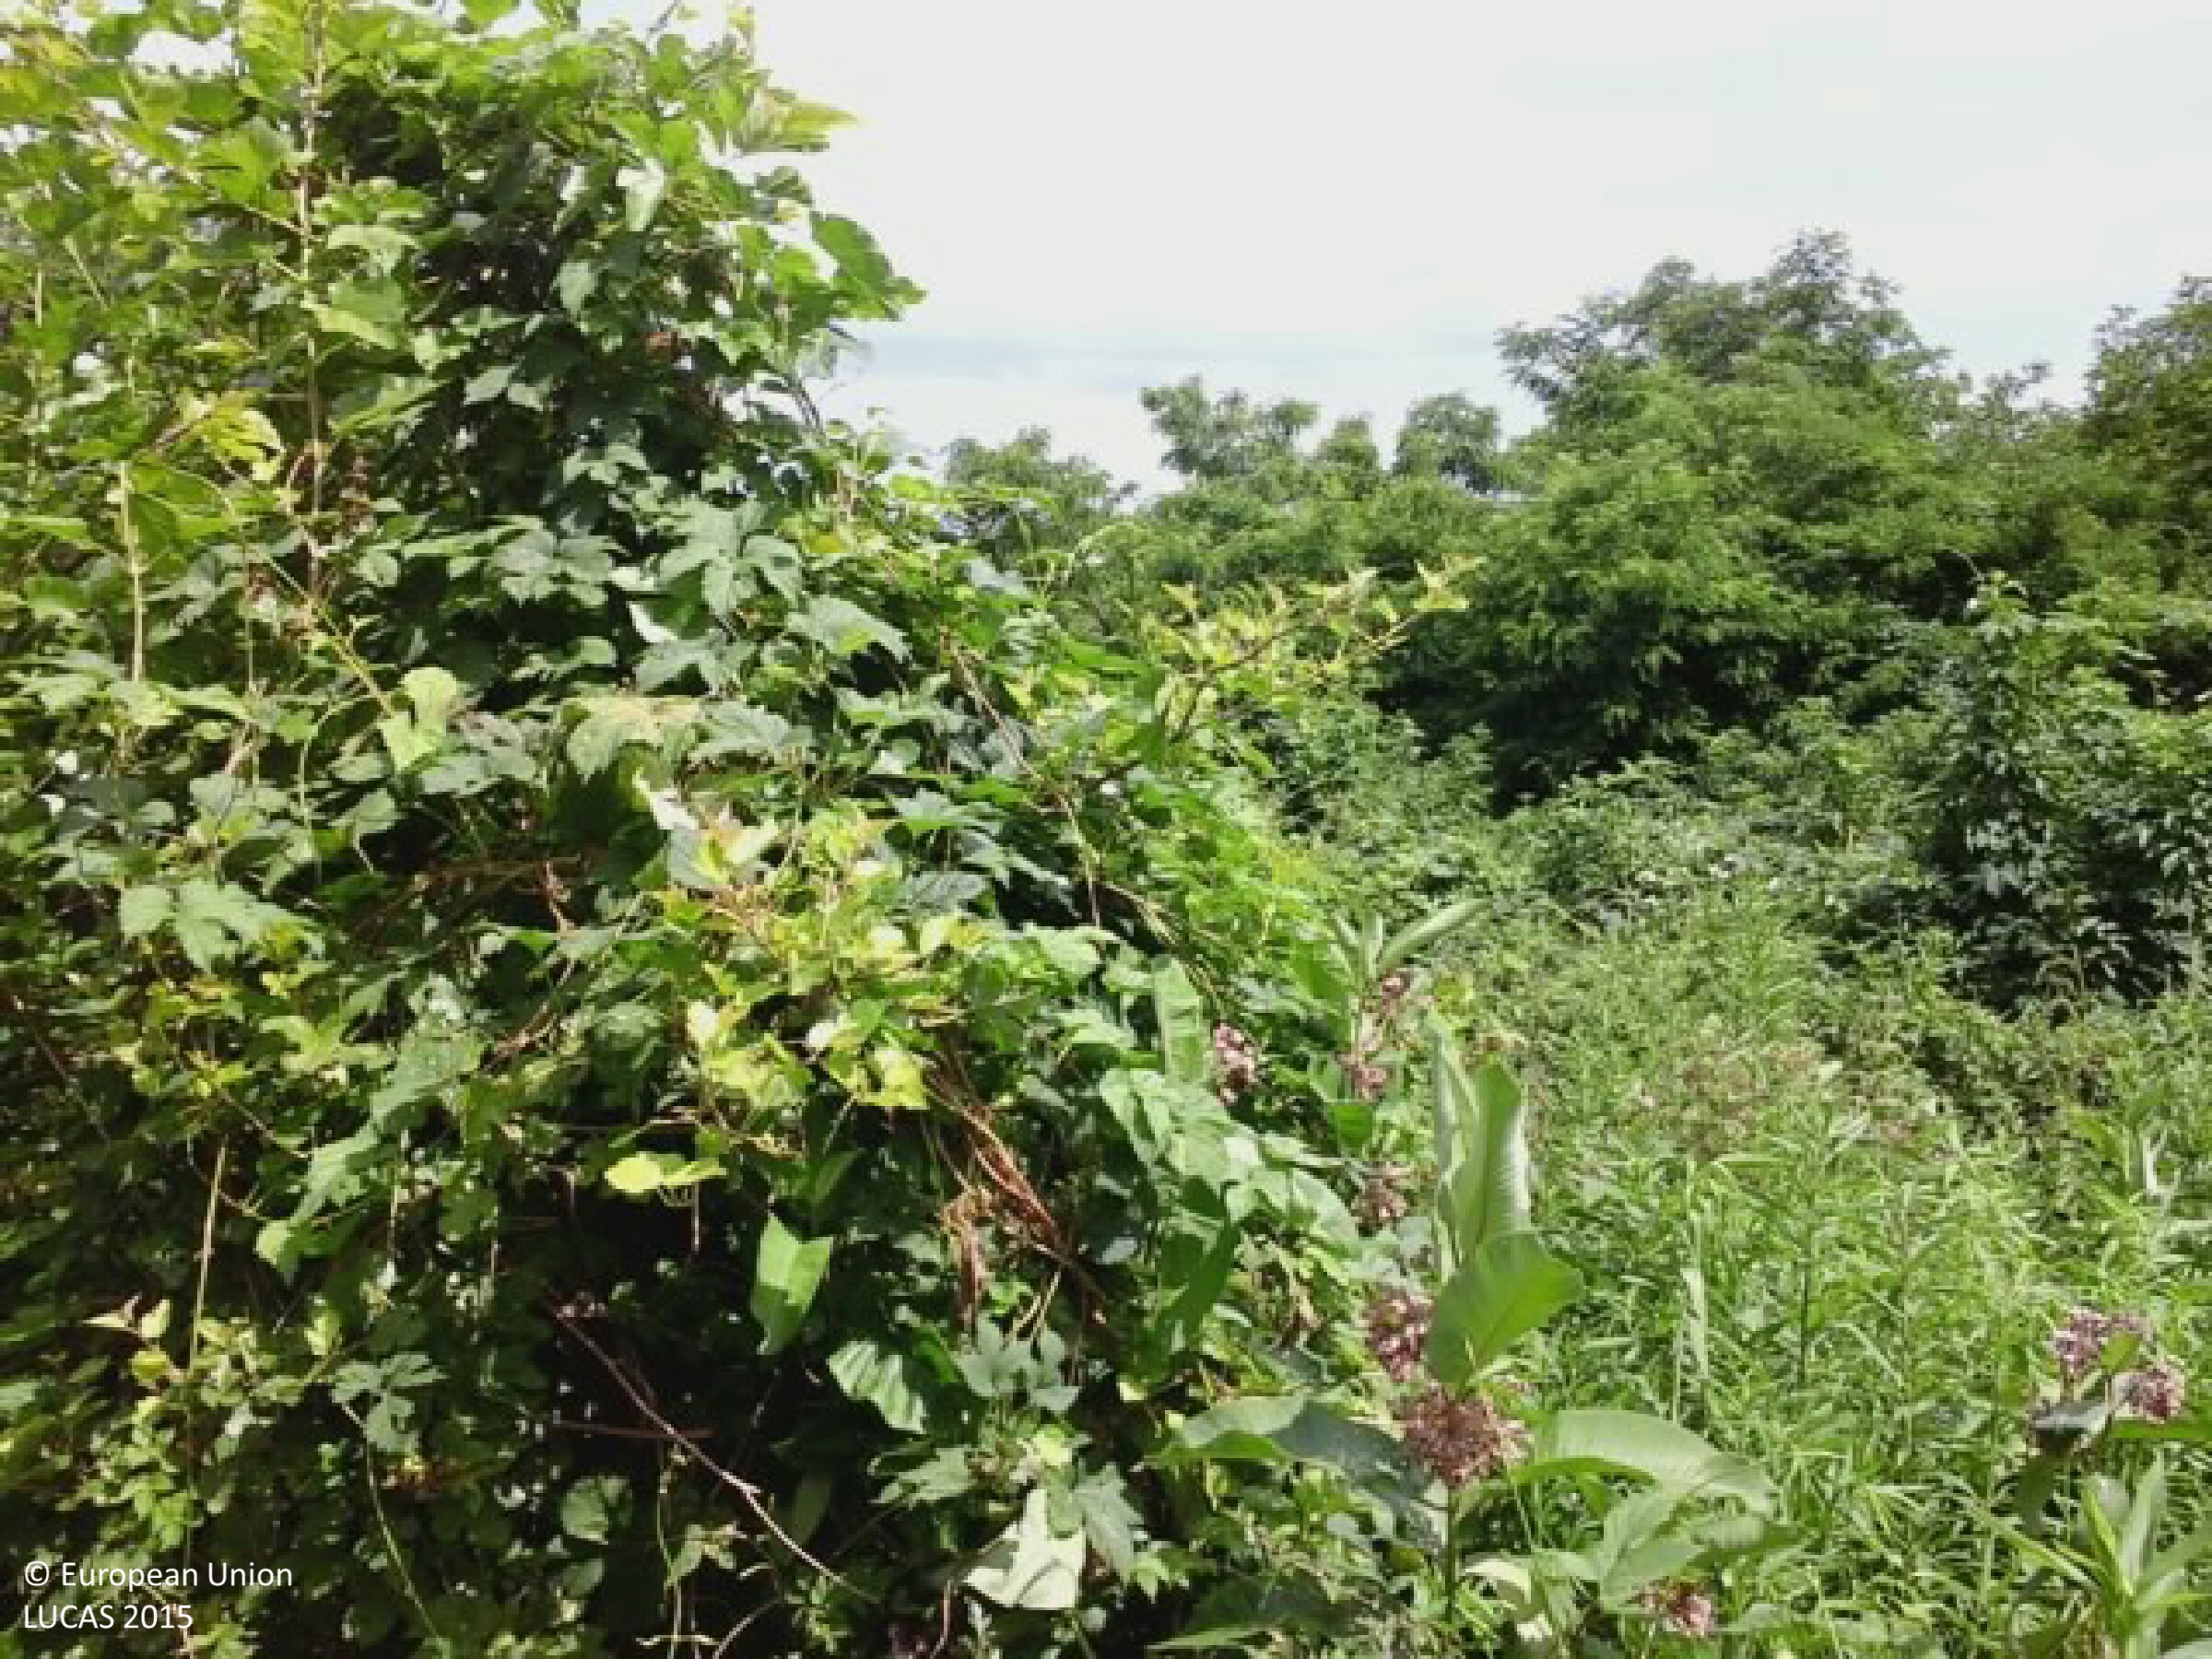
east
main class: Shrubland
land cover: Shrubland with sparse tree cover
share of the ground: > 75 %
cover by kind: shrubs 65 %, herbaceous plants 30 %, broadleaved forest trees 5 %
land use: Semi-natural and natural areas not in use
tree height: > 5 m
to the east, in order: Shrubland with sparse tree cover; Broadleaved woodland
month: June
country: HU
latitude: 47.5371
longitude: 19.3327
